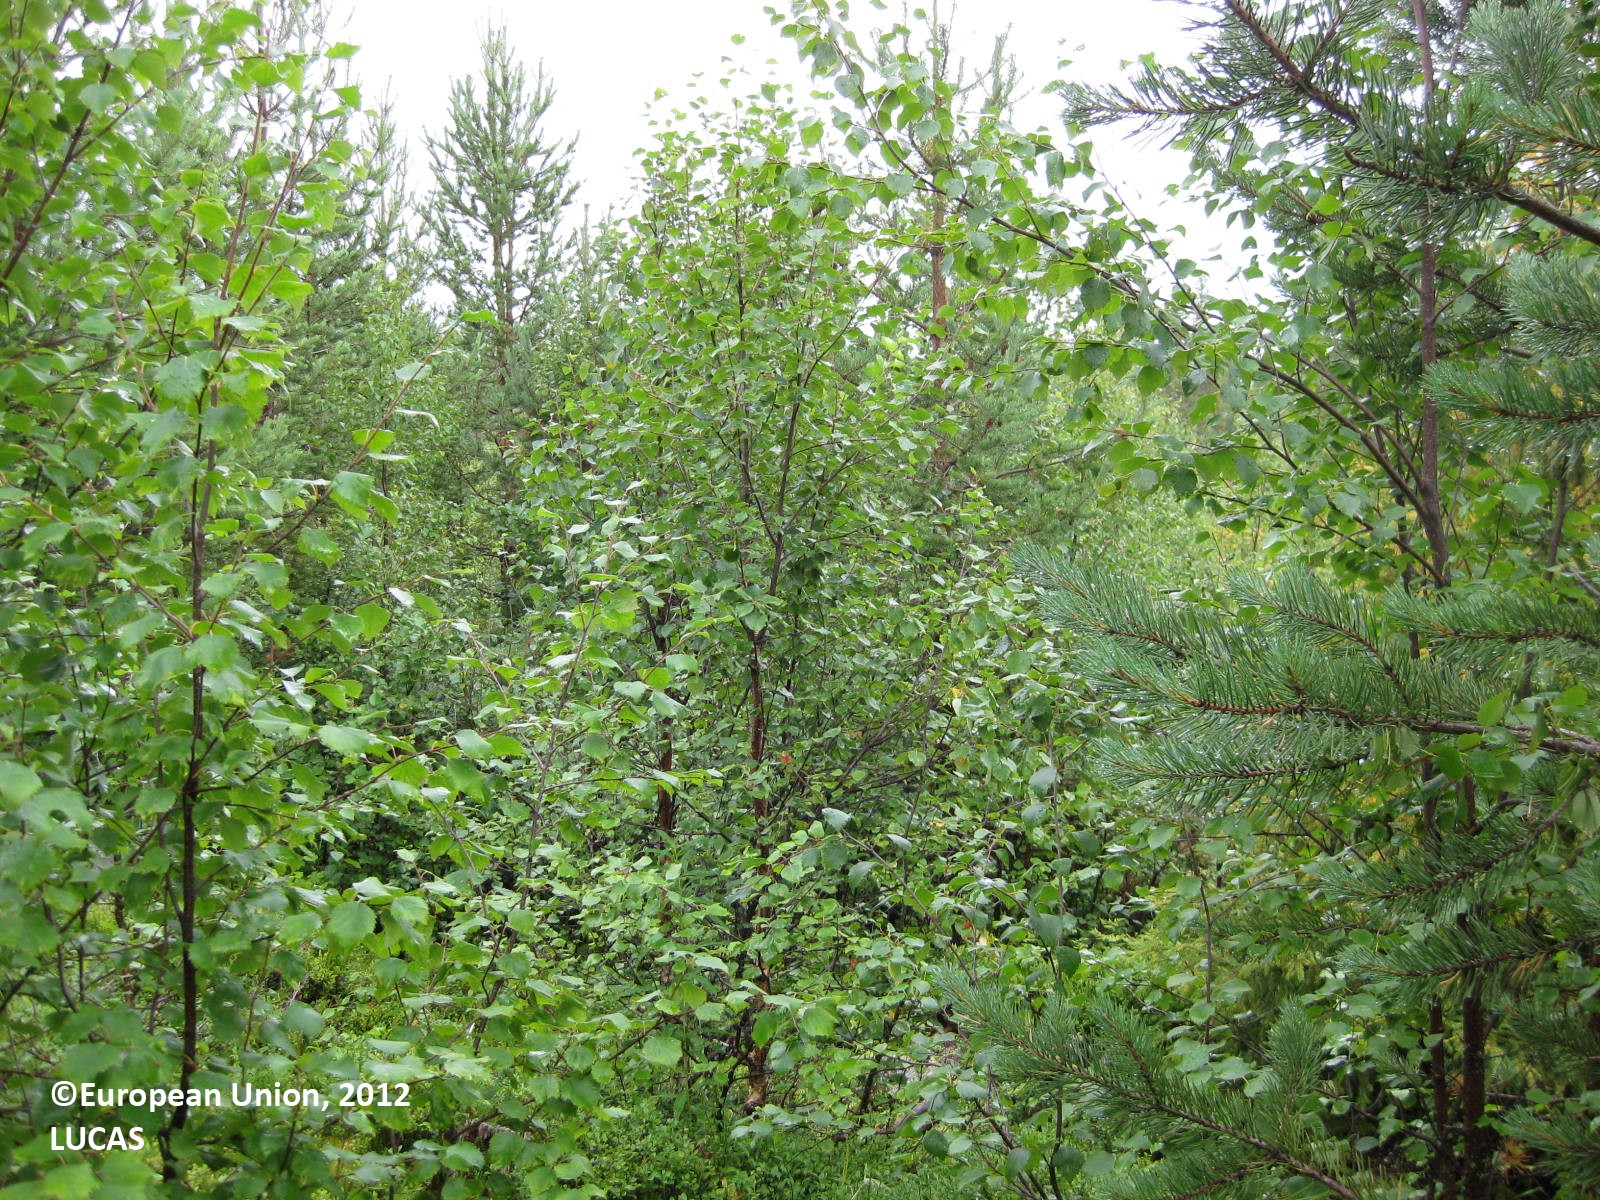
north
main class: Woodland
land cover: Pine dominated mixed woodland
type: boreal forest
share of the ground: > 75 %
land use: Forestry
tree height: > 5 m
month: August
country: FI
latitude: 66.0940
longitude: 28.2104
